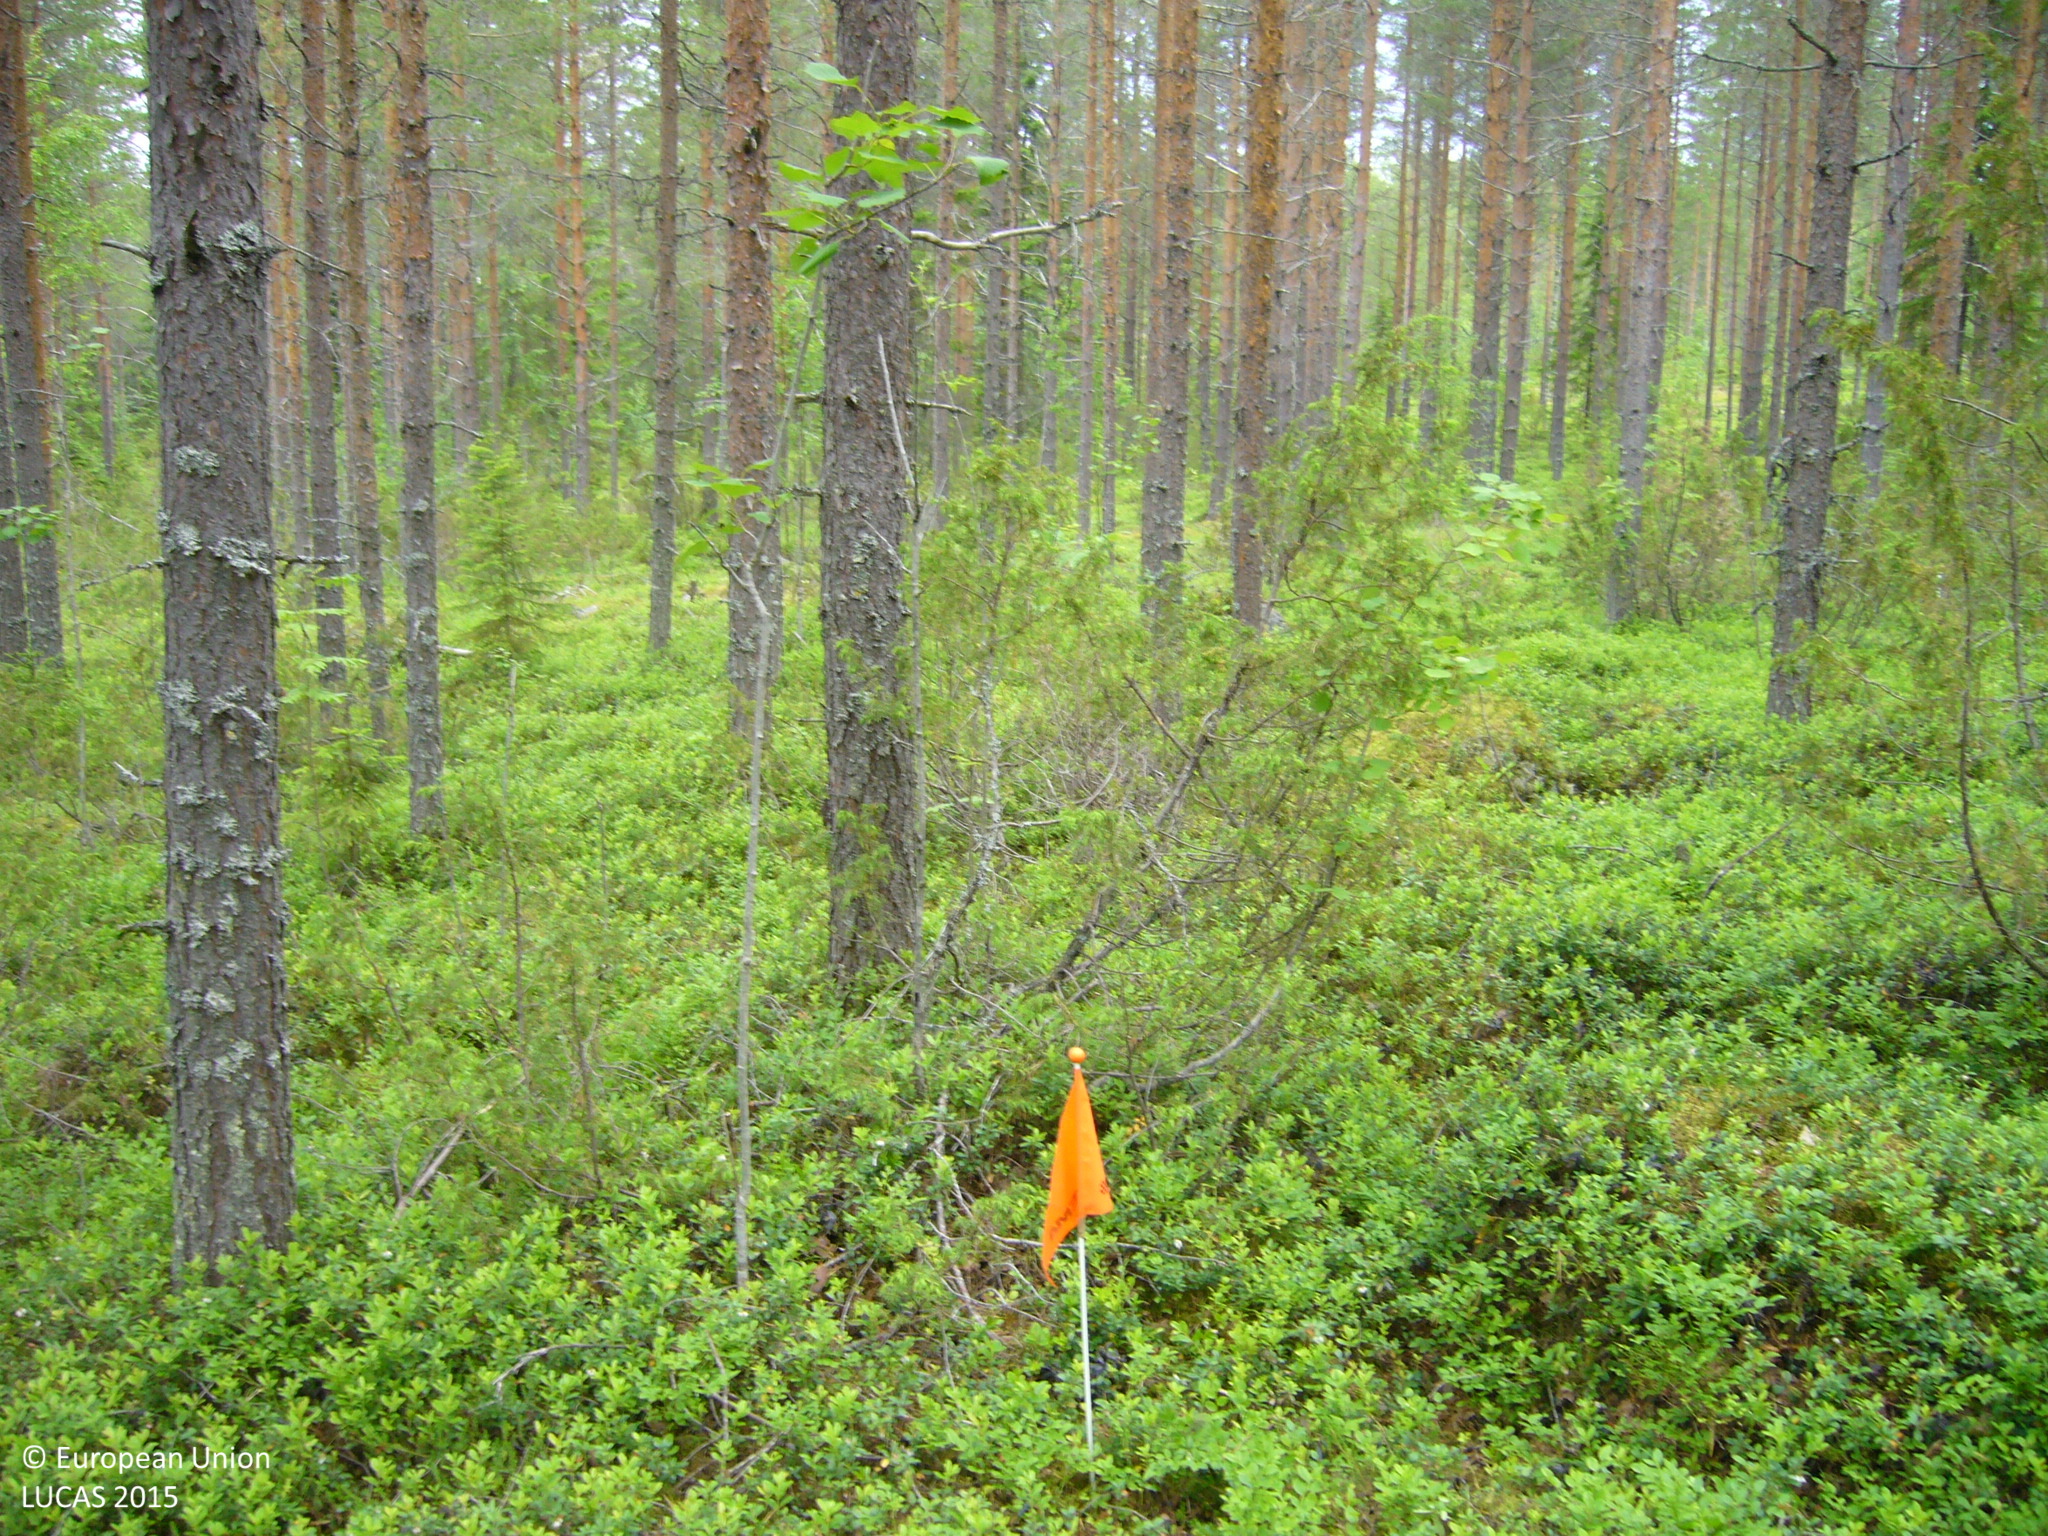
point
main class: Woodland
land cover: Pine dominated coniferous woodland
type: boreal forest
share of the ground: 50 - 75 %
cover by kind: coniferous forest trees 60 %, shrubs 40 %
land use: Forestry
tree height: > 5 m
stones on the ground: 25 - 50 %
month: July
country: FI
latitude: 63.4266
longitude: 26.2090
